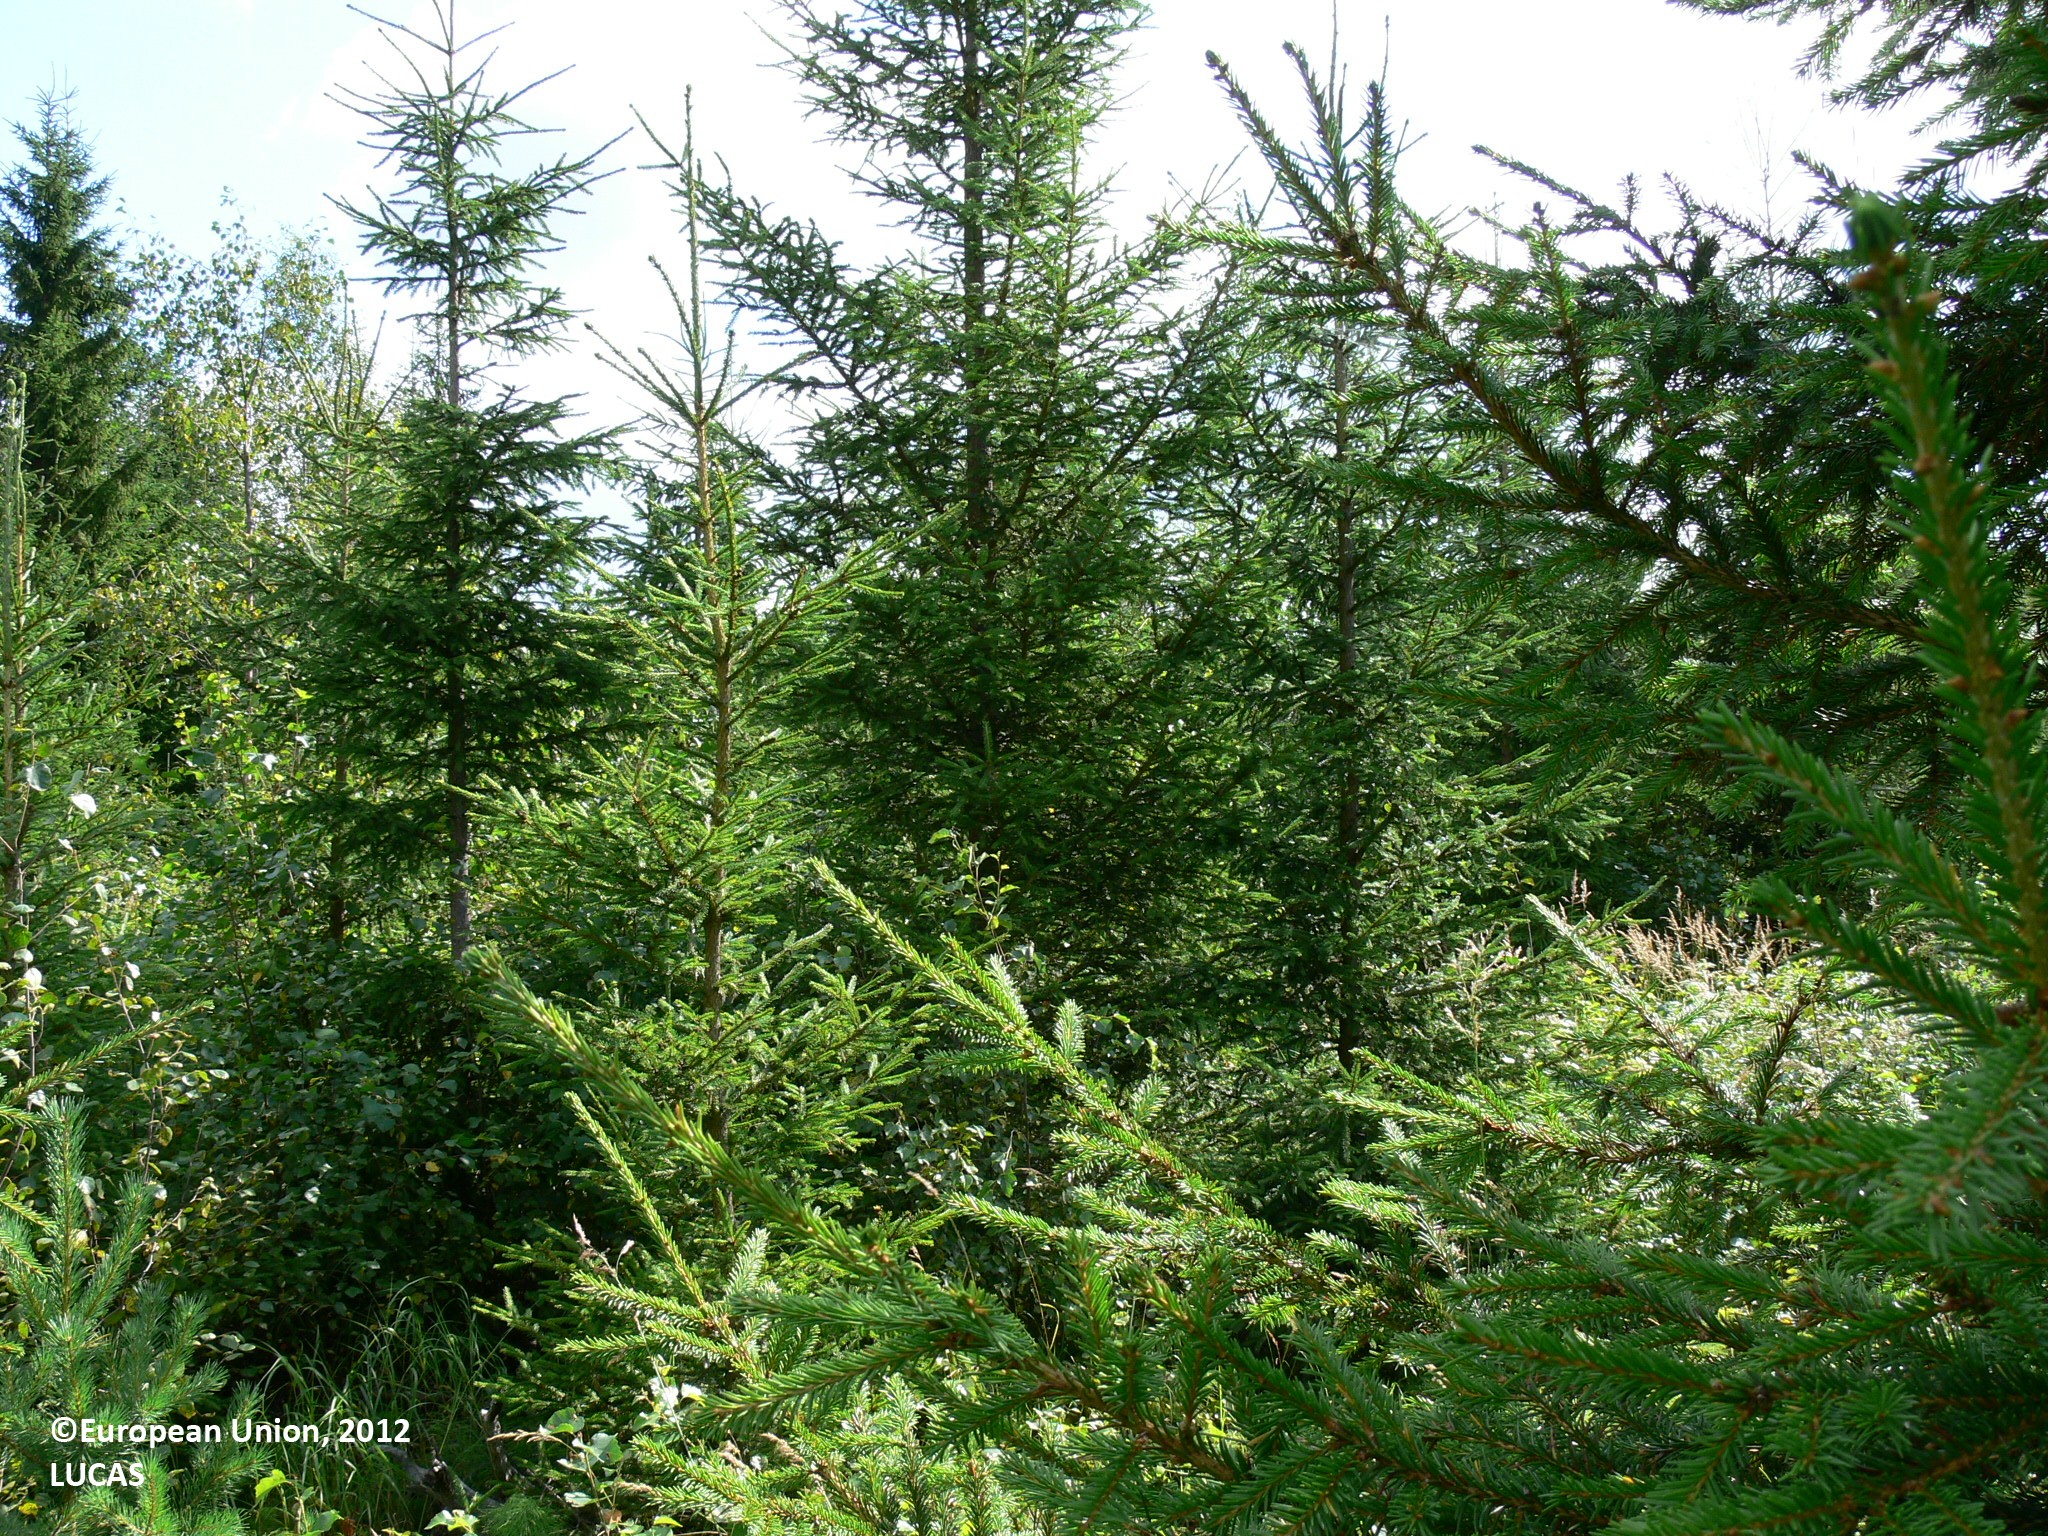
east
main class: Woodland
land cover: Spruce dominated mixed woodland
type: boreal forest
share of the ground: 50 - 75 %
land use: Forestry
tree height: < 5 m
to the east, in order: Spruce dominated mixed woodland; Ditches and canals; Spruce dominated mixed woodland; Ditches and canals; Spruce dominated mixed woodland; Ditches and canals; Spruce dominated mixed woodland; Ditches and canals; Spruce dominated mixed woodland; Ditches and canals; Spruce dominated mixed woodland; Ditches and canals; Spruce dominated mixed woodland; Ditches and canals; Spruce dominated mixed woodland; Ditches and canals; Spruce dominated mixed woodland
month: August
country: FI
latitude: 61.9608
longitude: 29.2873
